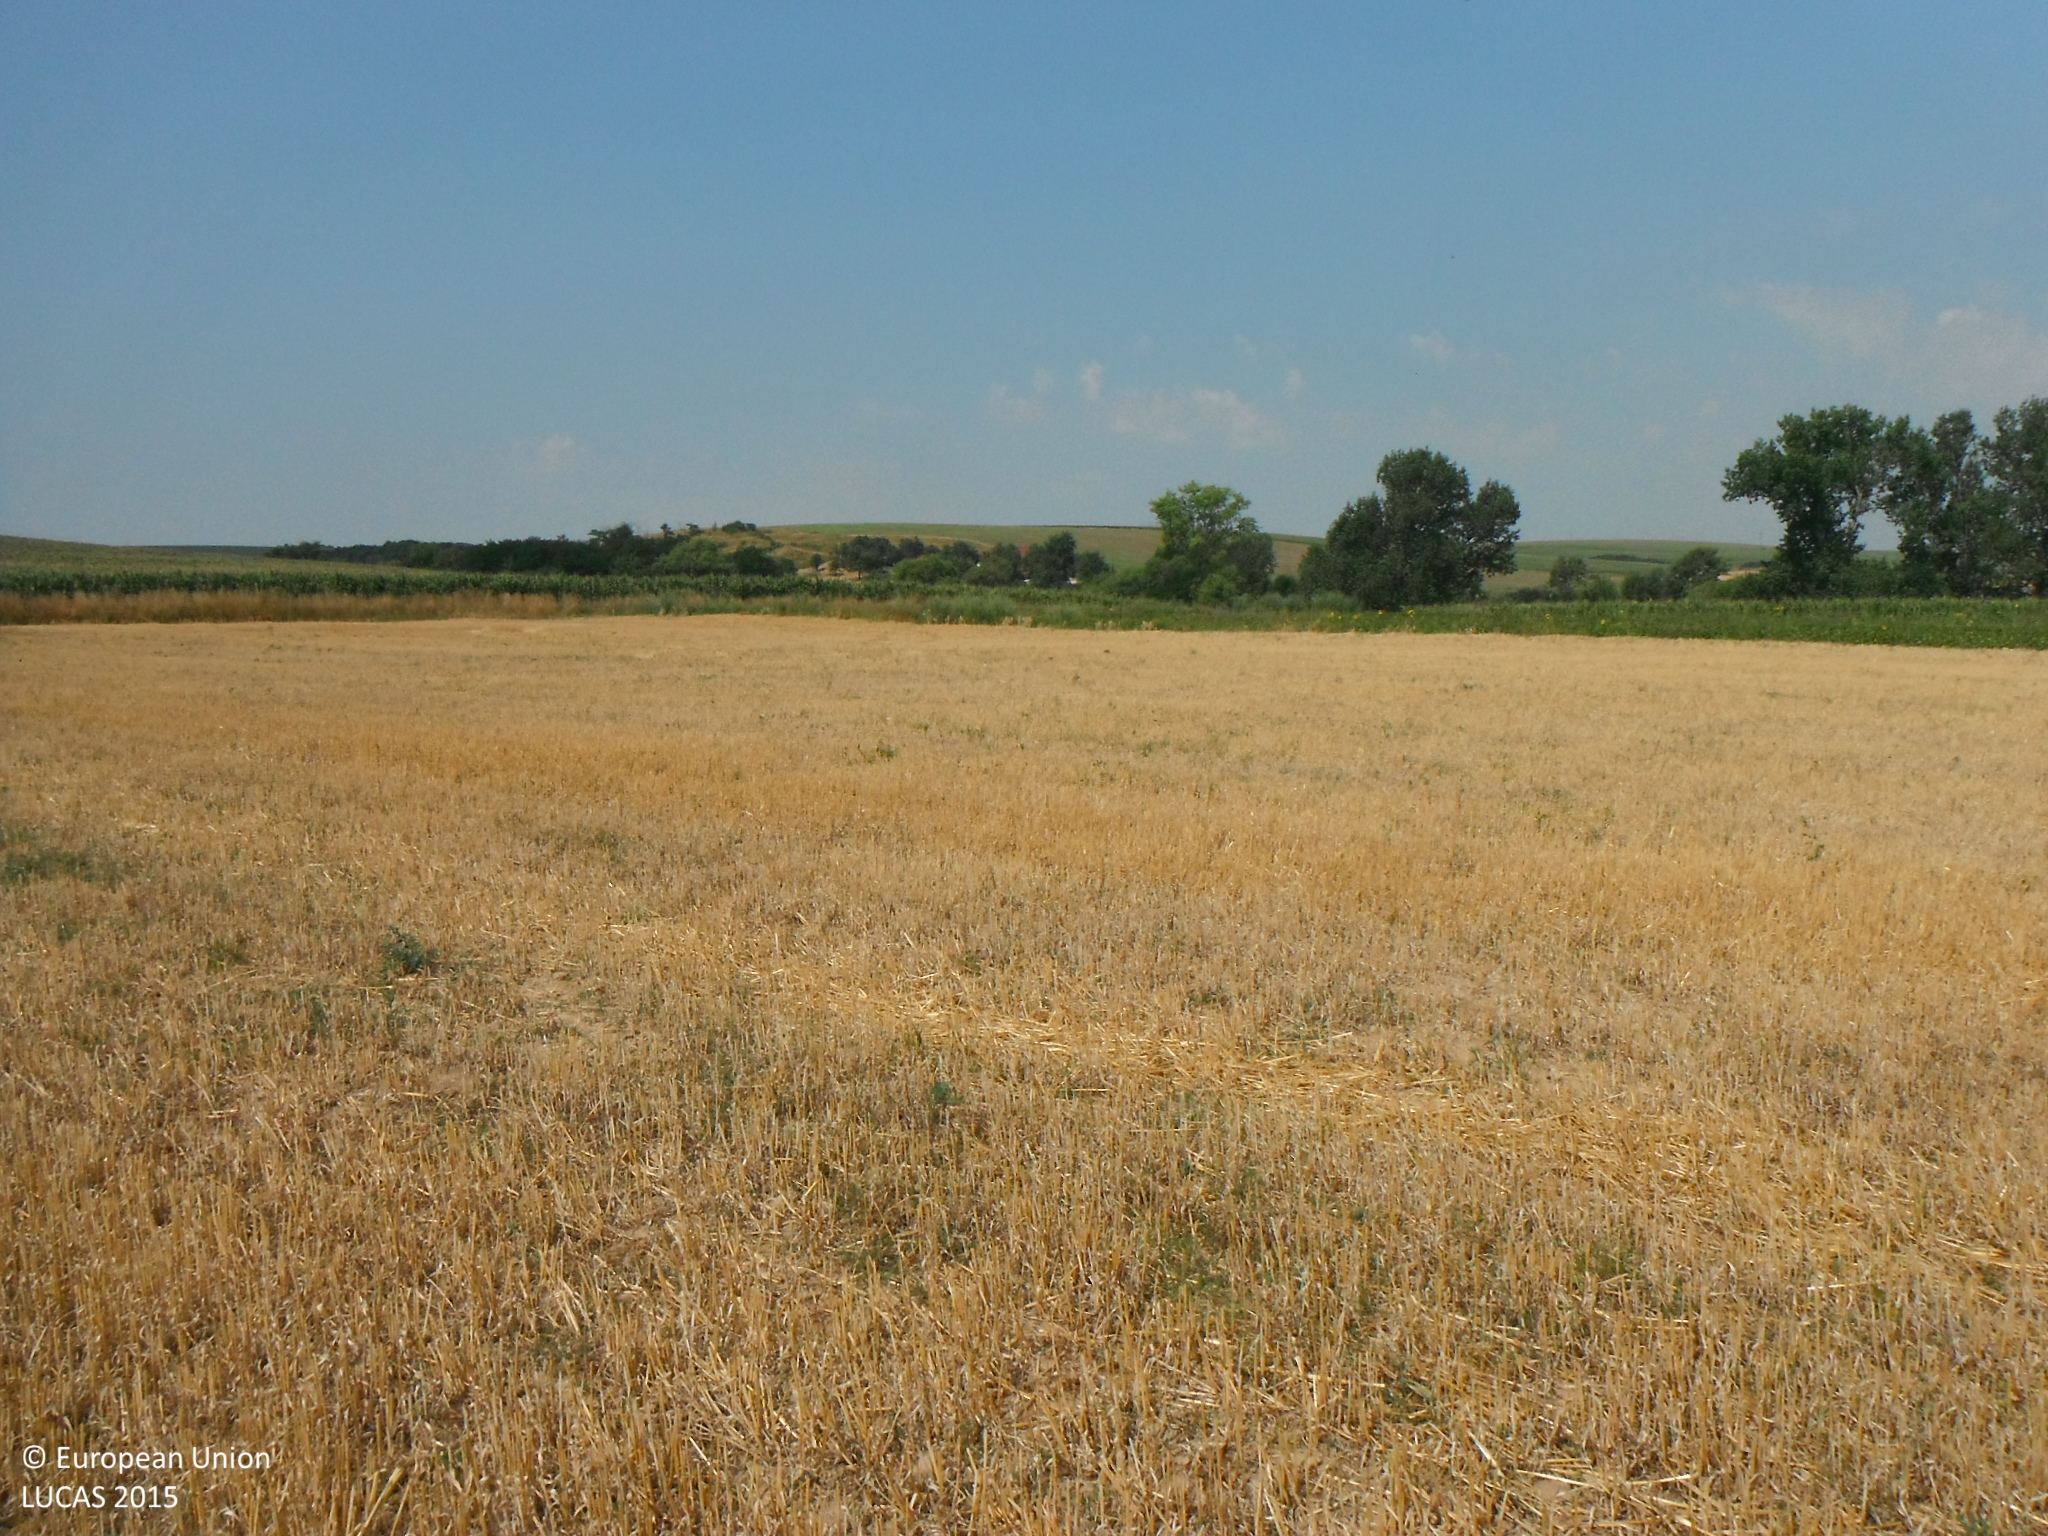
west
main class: Cropland
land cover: Barley
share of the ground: > 75 %
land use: Agriculture (excluding fallow land and kitchen gardens)
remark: Harvested field
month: July
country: SK
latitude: 48.3251
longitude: 20.0507
